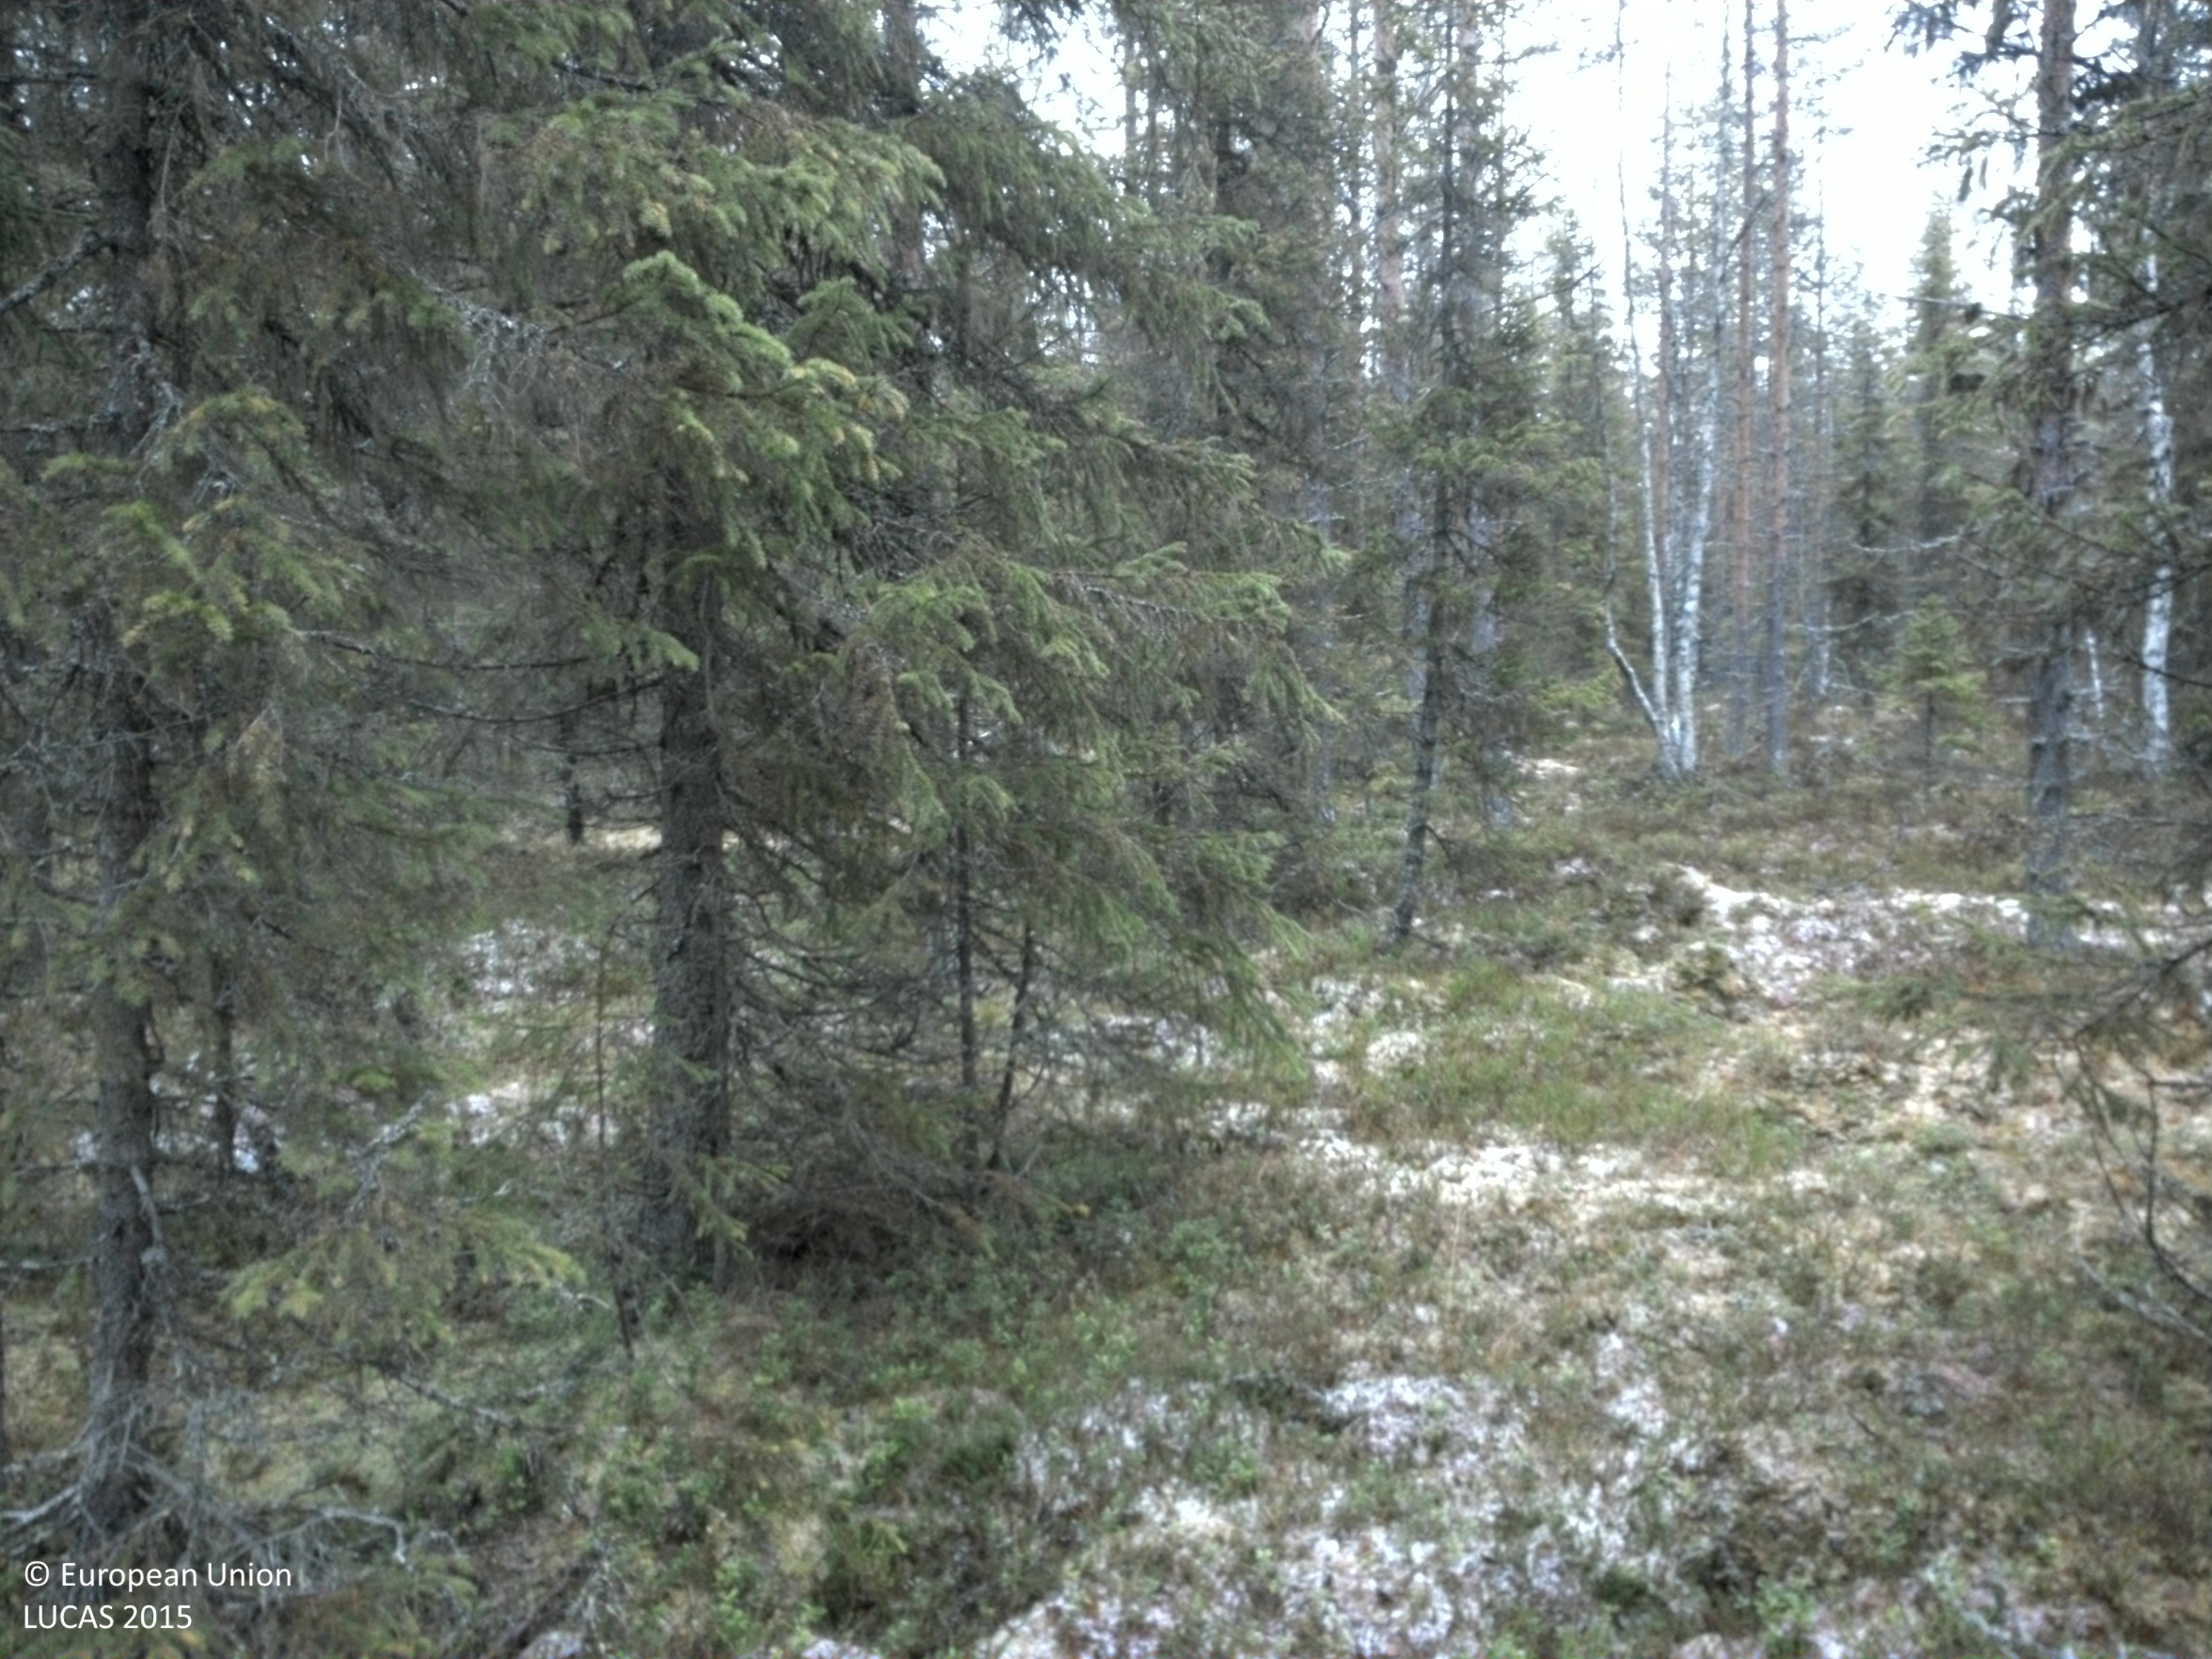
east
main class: Woodland
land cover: Other coniferous woodland
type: boreal forest
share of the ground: 25 - 50 %
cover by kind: coniferous forest trees 35 %, shrubs 35 %, lichens and mosses 20 %, broadleaved forest trees 5 %, herbaceous plants 5 %
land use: Forestry
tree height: > 5 m
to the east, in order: Other coniferous woodland; Ditches and canals; Other coniferous woodland; Pine dominated coniferous woodland
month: October
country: SE
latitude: 64.3636
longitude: 16.7423
